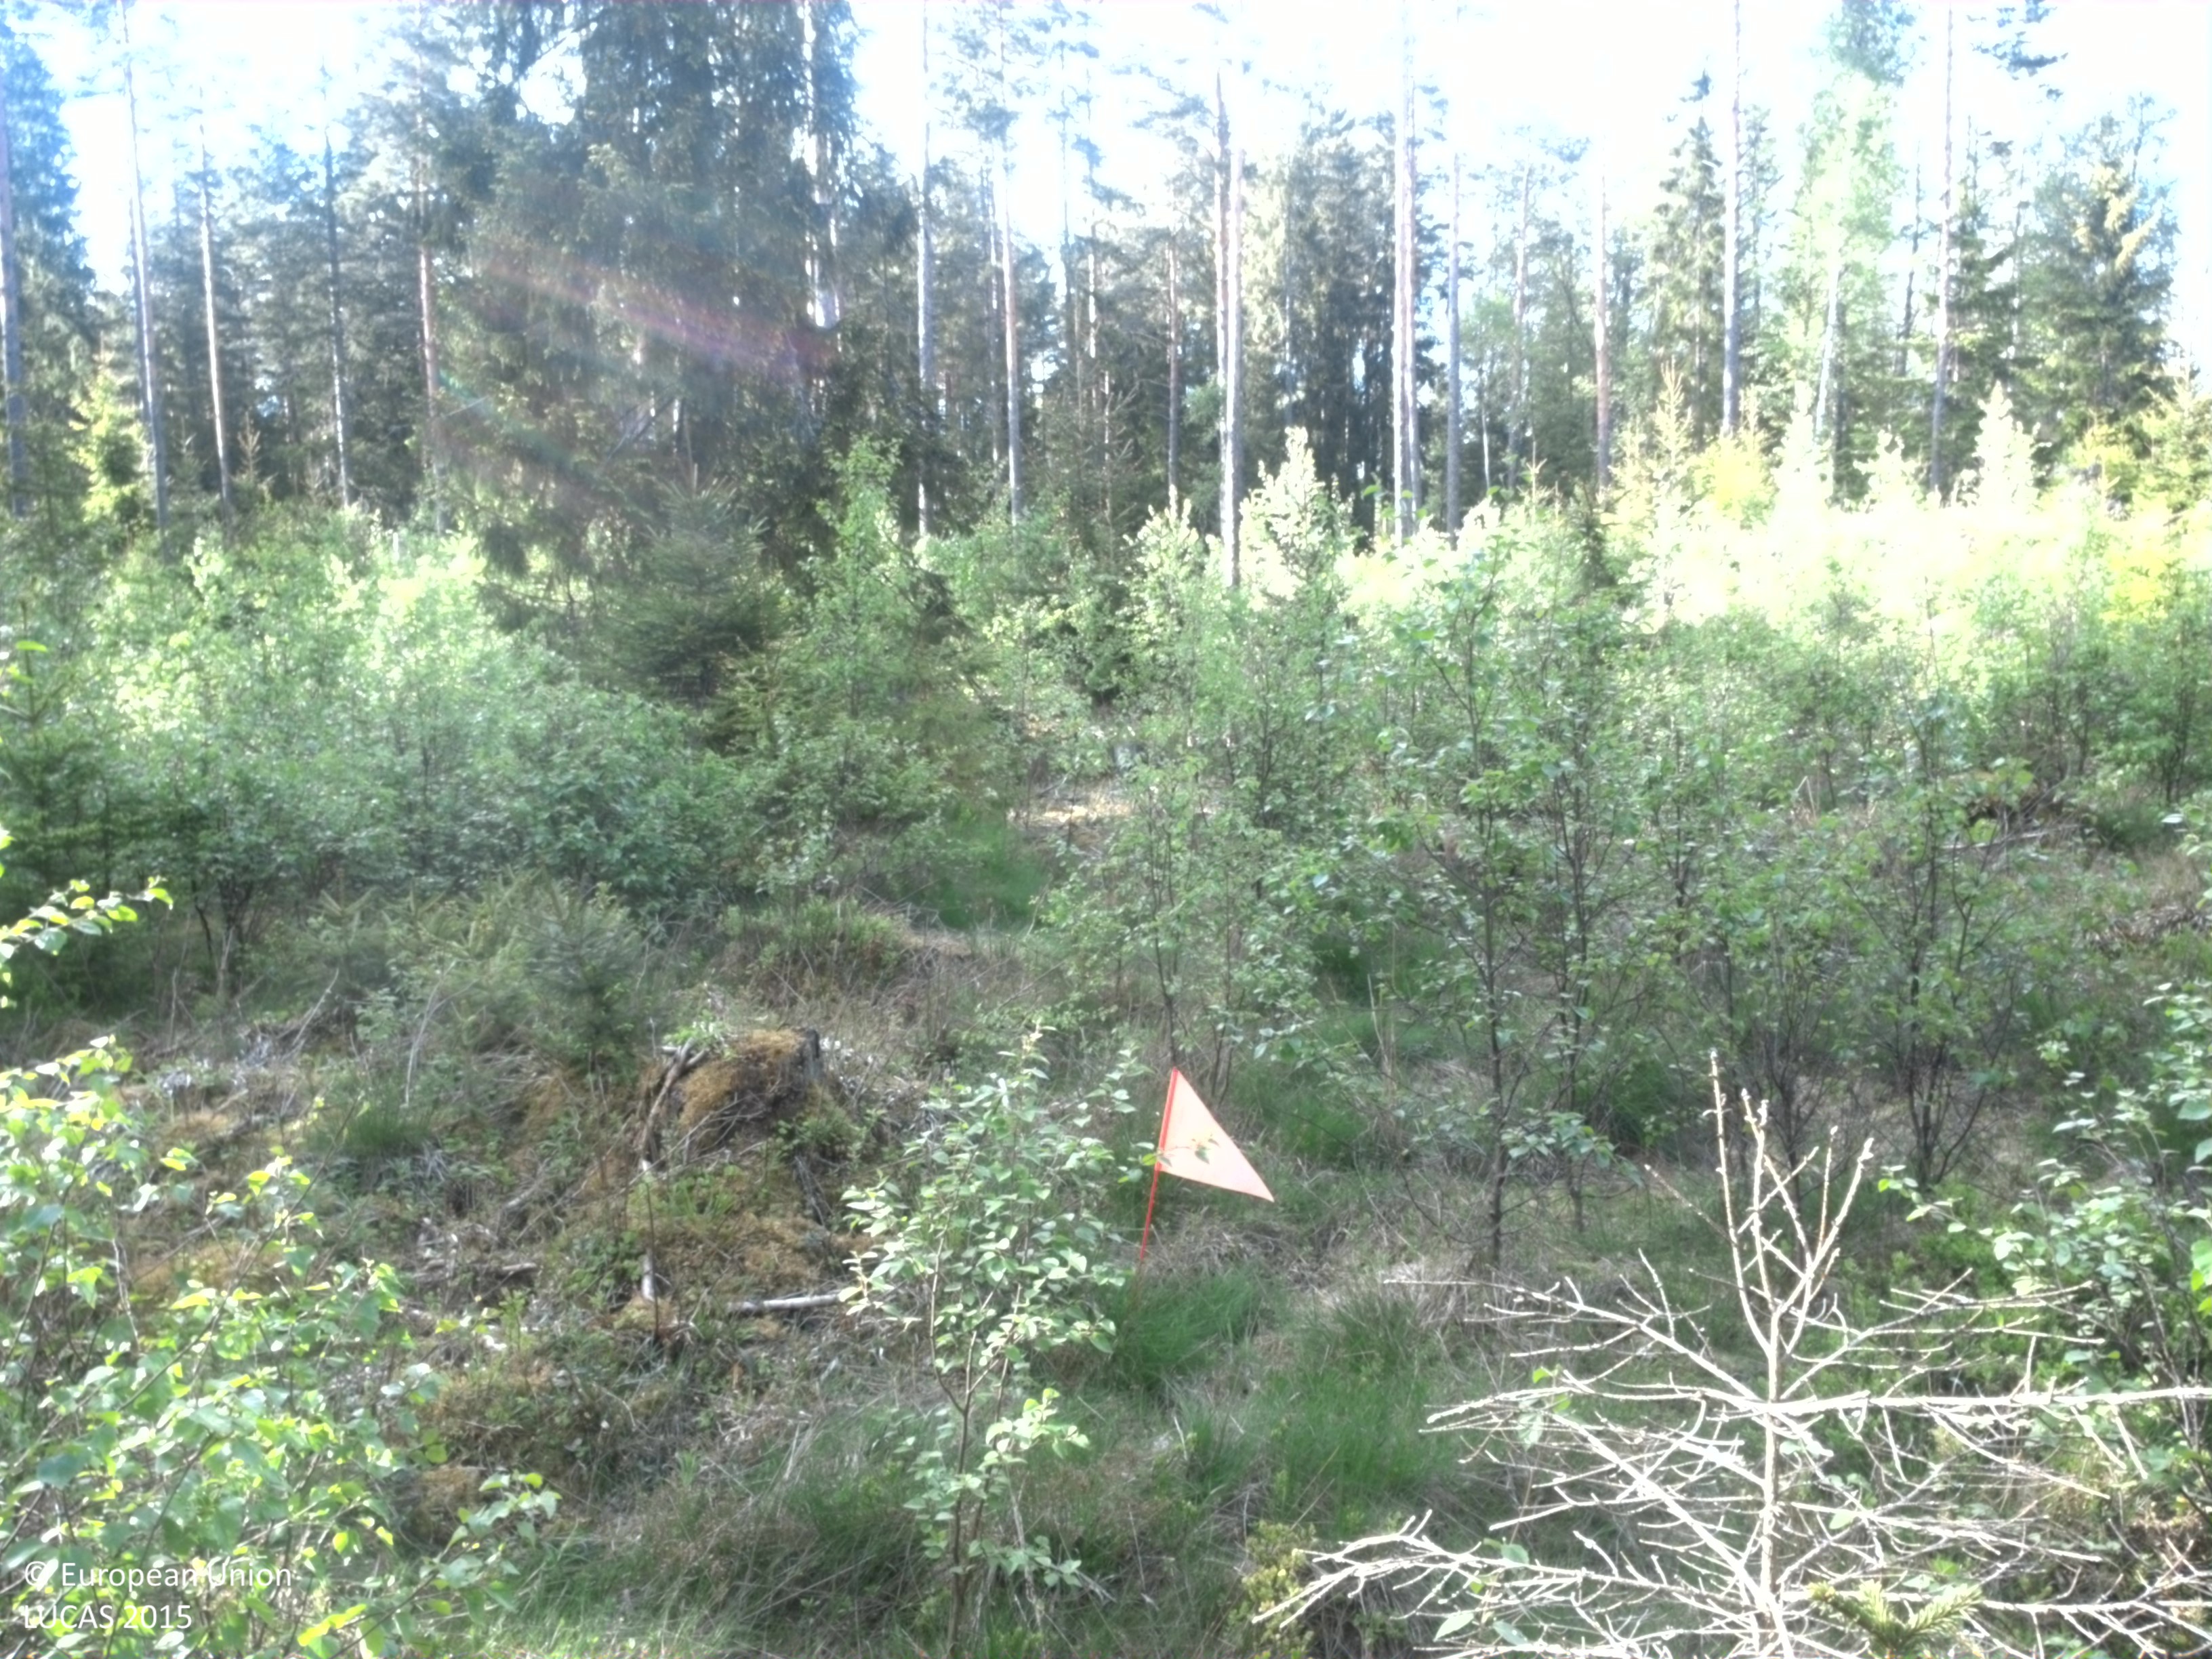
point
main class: Woodland
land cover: Spruce dominated mixed woodland
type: boreal forest
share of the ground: 25 - 50 %
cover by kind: coniferous forest trees 25 %, broadleaved forest trees 25 %, shrubs 20 %, herbaceous plants 20 %, lichens and mosses 10 %
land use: Forestry
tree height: > 5 m
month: May
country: SE
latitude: 57.3103
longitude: 15.9913
